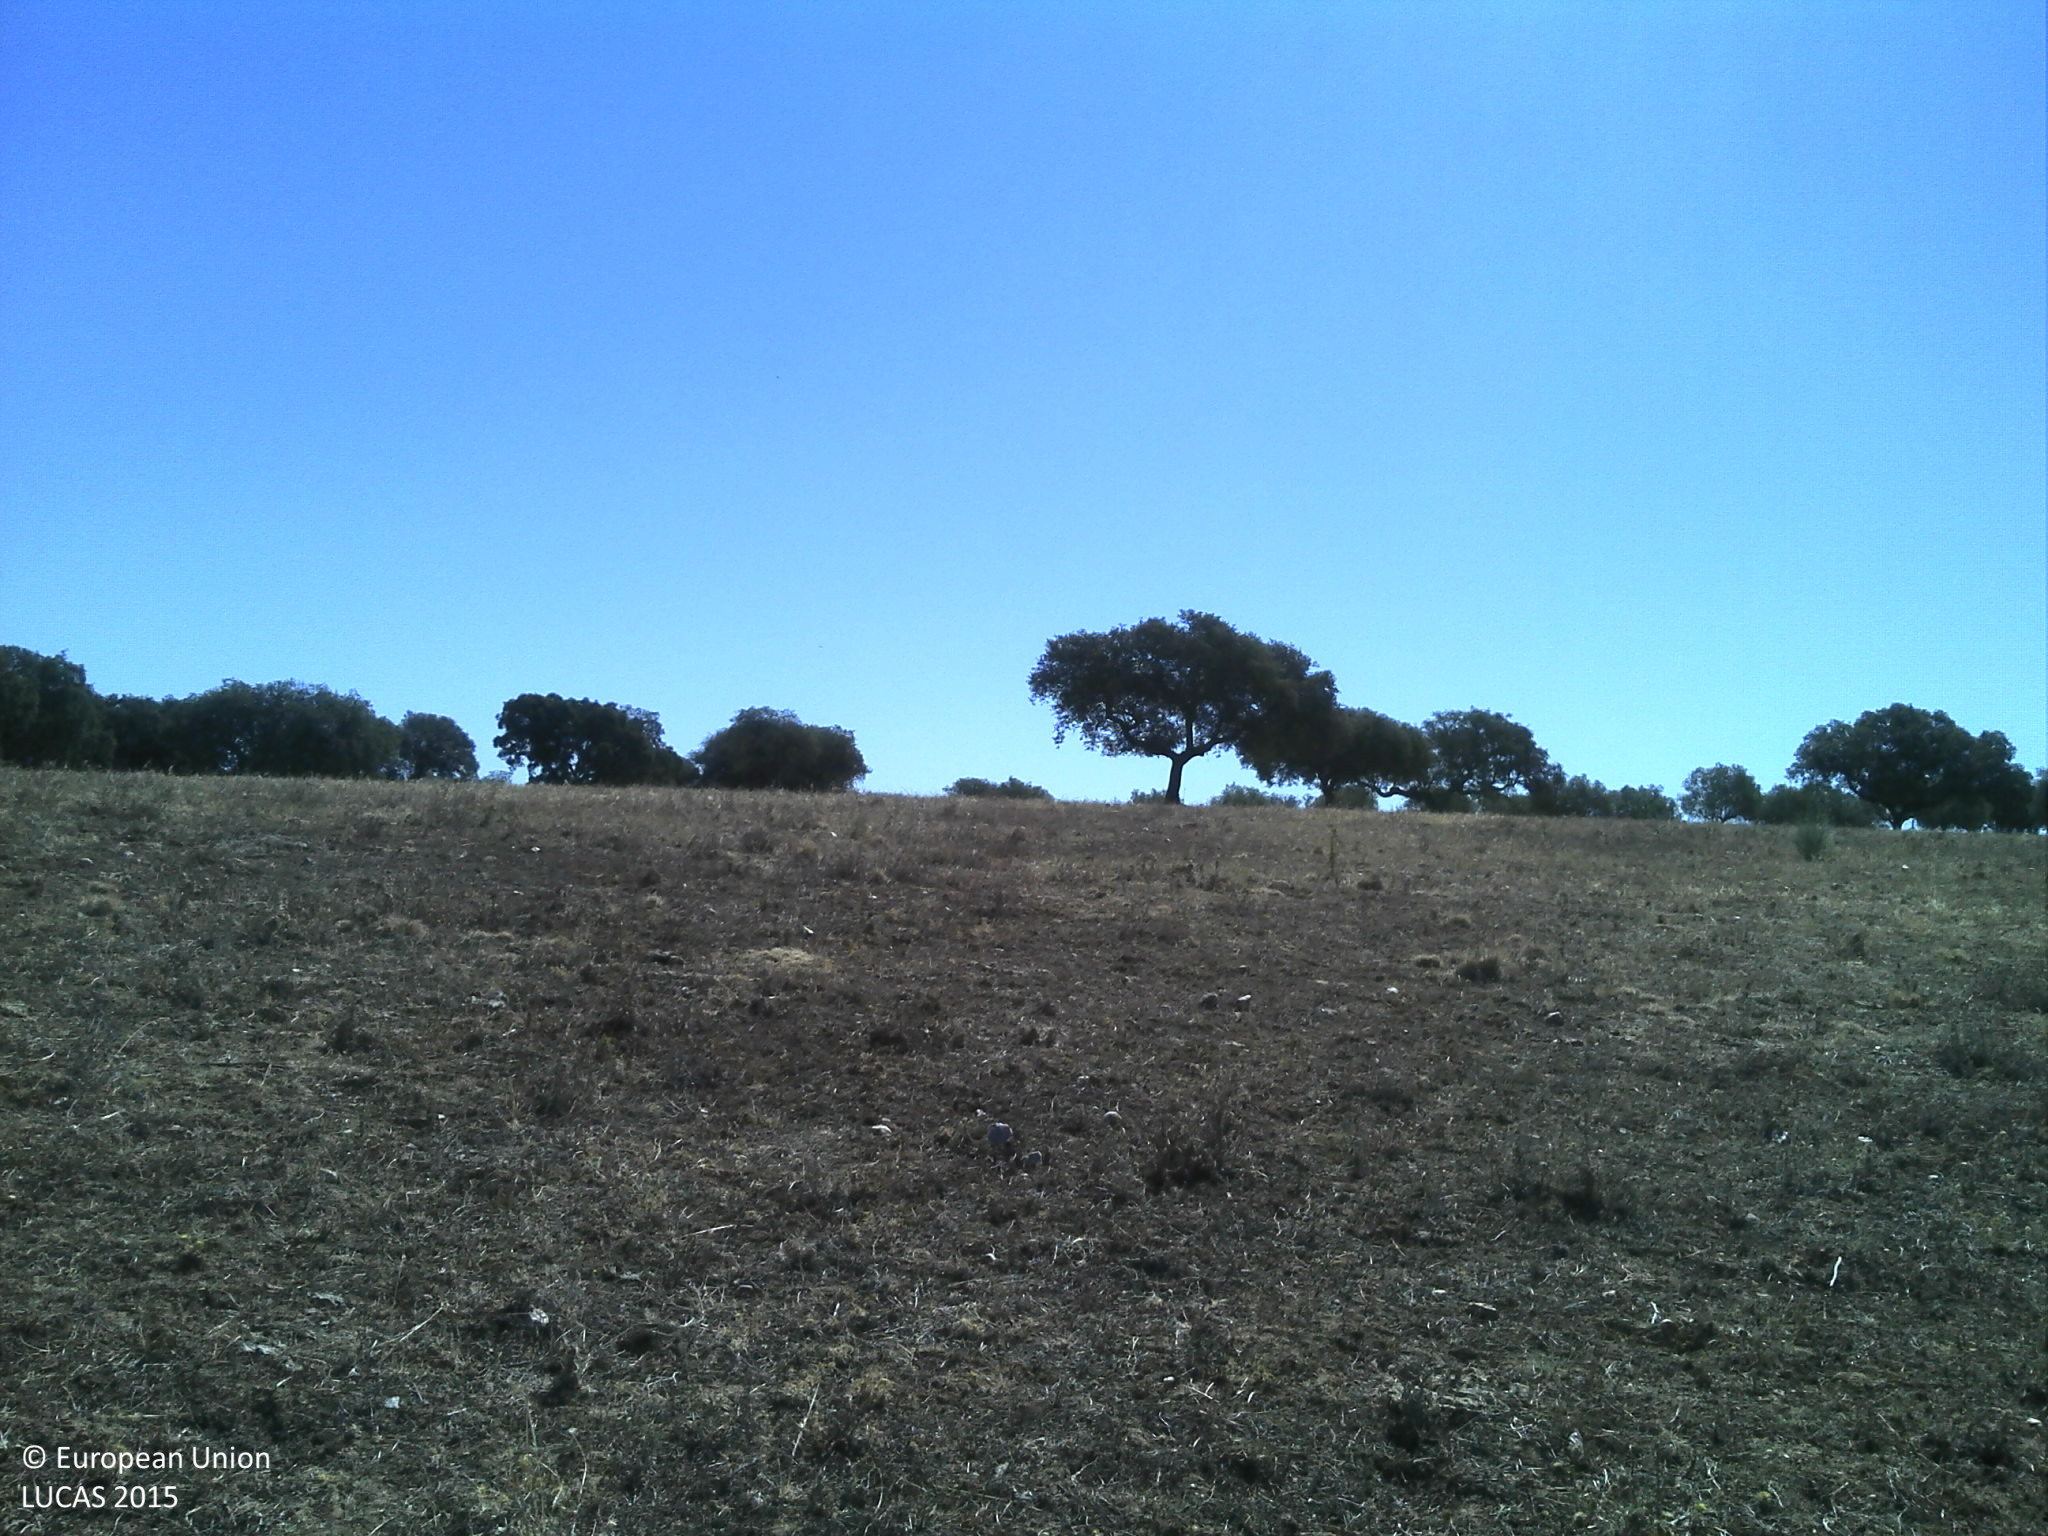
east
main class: Grassland
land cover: Grassland without tree/shrub cover
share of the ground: 10 - 25 %
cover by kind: unconsolidated bare surface 85 %, herbaceous plants 15 %
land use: Agriculture (excluding fallow land and kitchen gardens)
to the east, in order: Grassland without tree/shrub cover; Single bushes/trees; Grassland without tree/shrub cover; Broadleaved woodland; Grass margins; Tracks; Grass margins; Lines of trees; Grassland without tree/shrub cover; Tracks; Lines of trees; Grassland without tree/shrub cover; Single bushes/trees; Grassland without tree/shrub cover; Broadleaved woodland; Grassland without tree/shrub cover; Broadleaved woodland
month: July
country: PT
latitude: 39.0765
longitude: -7.1503
